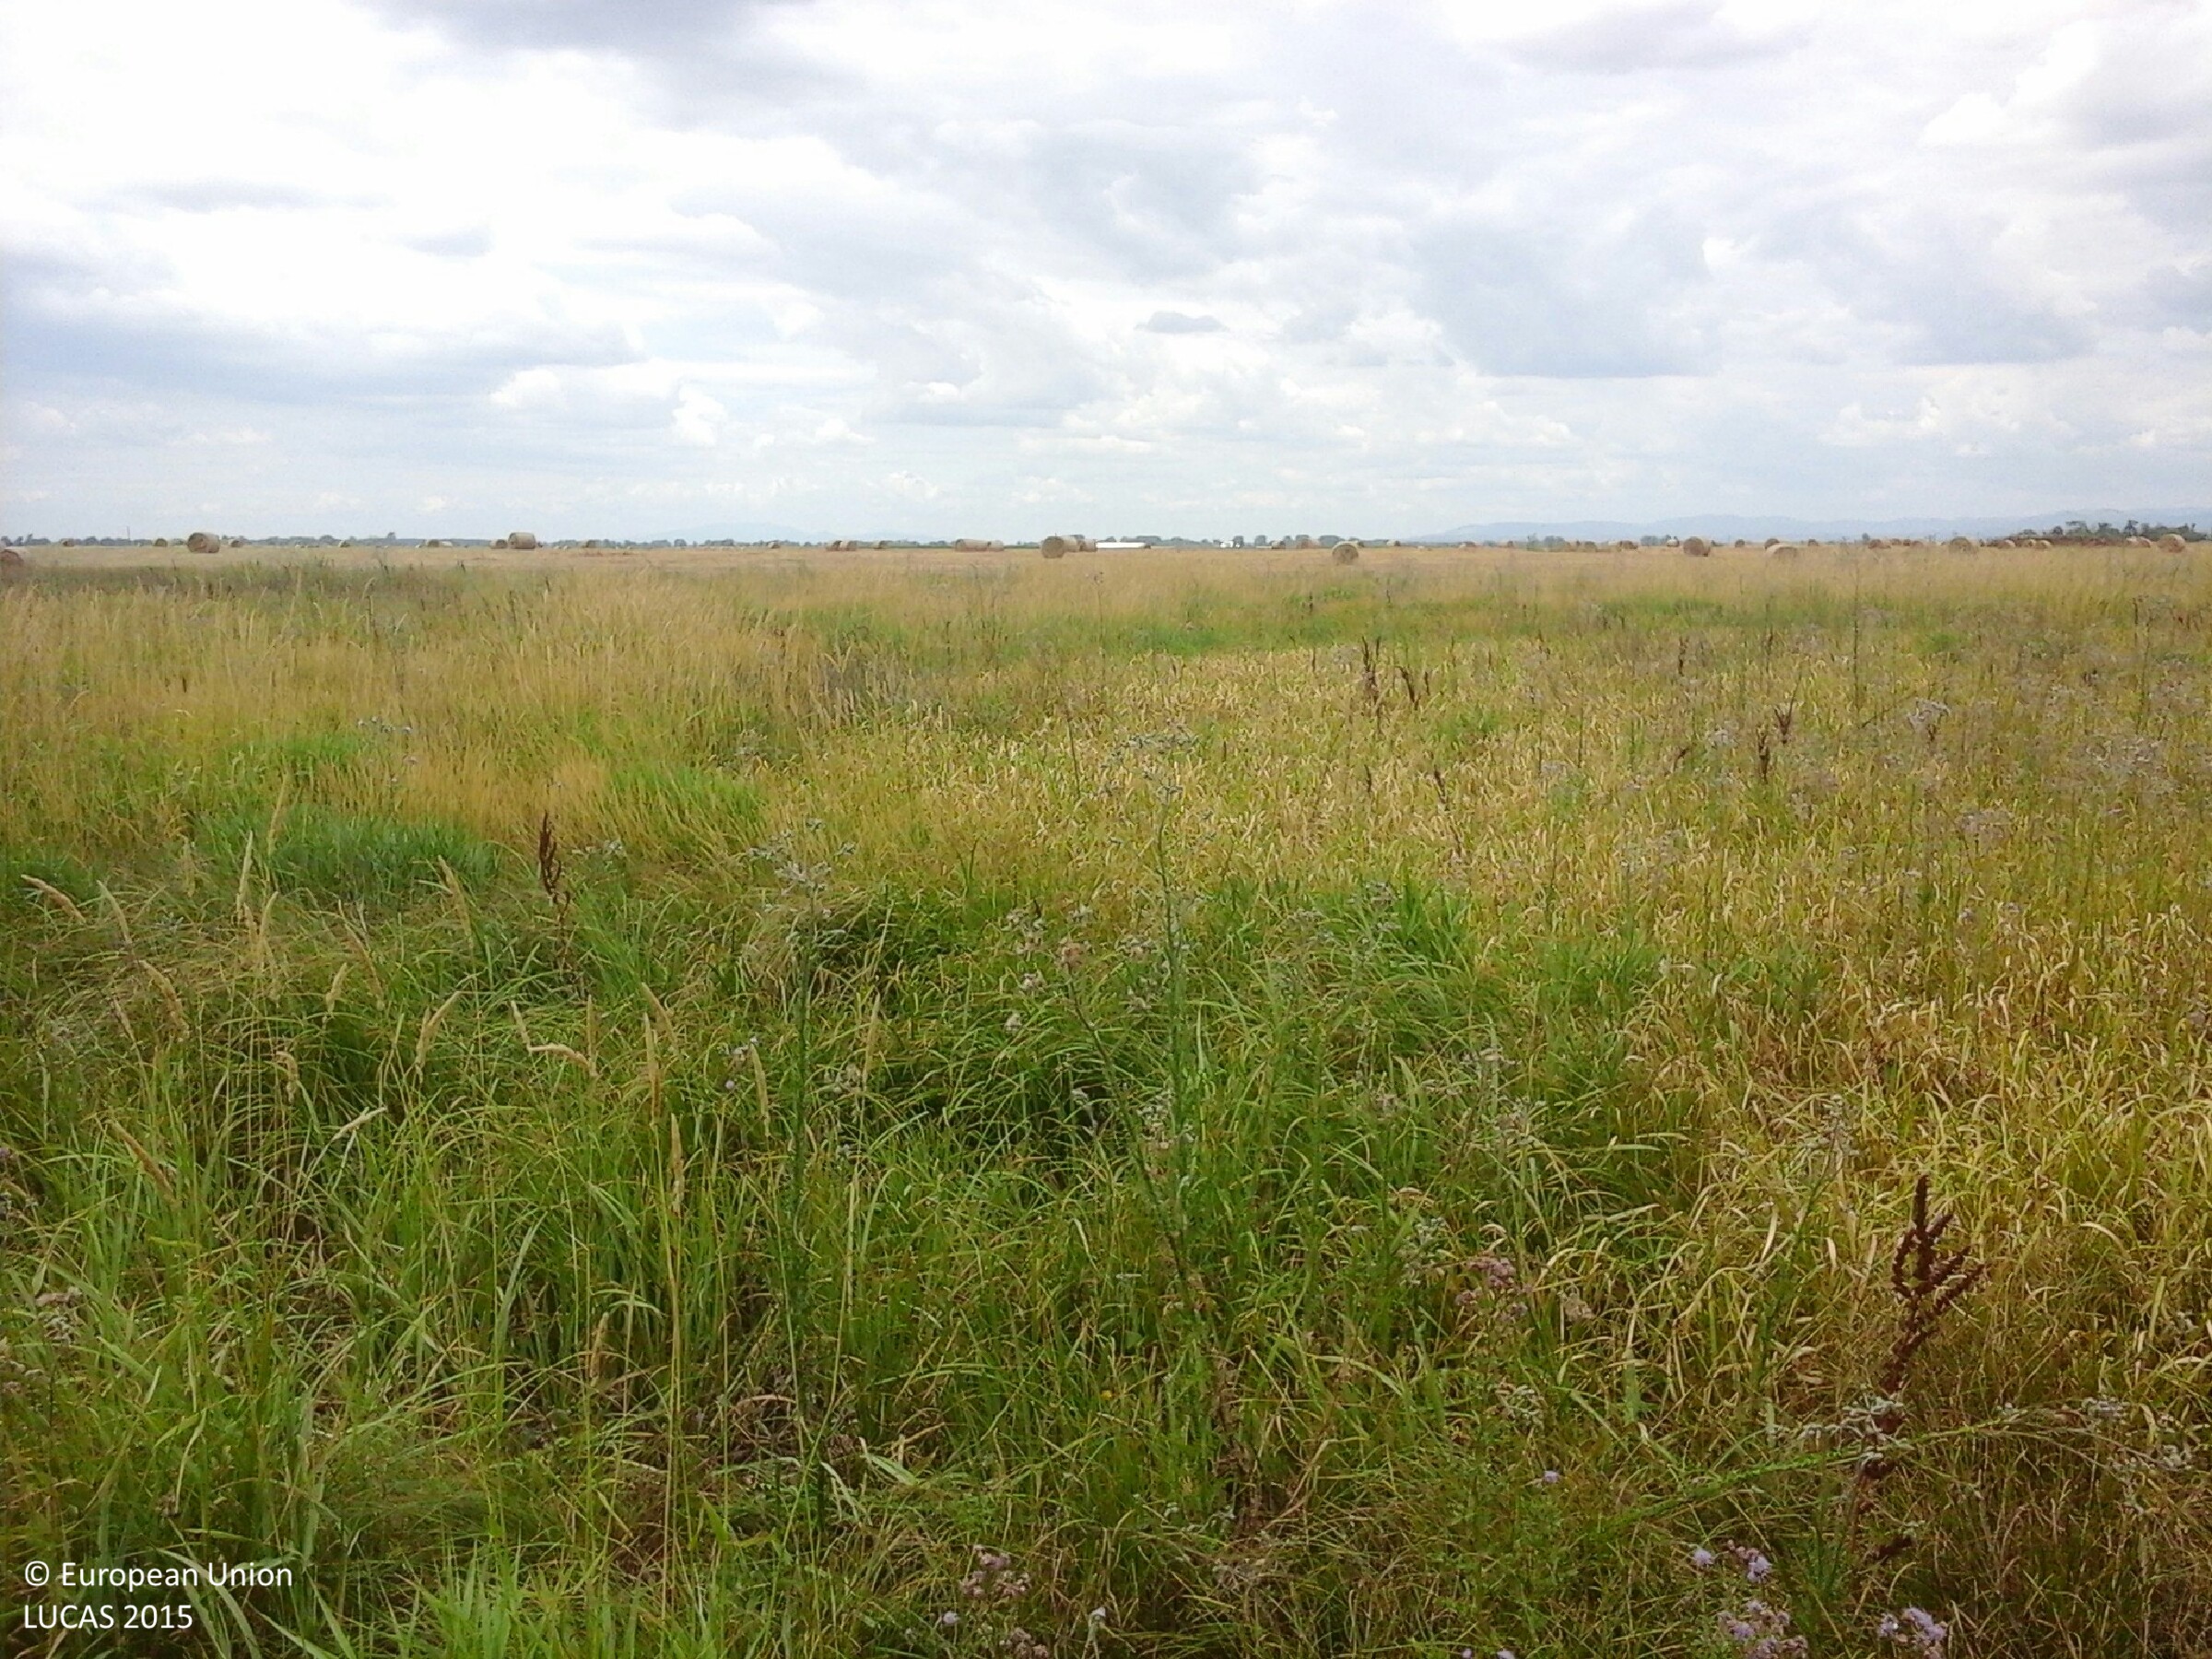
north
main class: Grassland
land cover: Grassland without tree/shrub cover
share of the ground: > 75 %
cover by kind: herbaceous plants 100 %
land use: Agriculture (excluding fallow land and kitchen gardens)
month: July
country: HU
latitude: 47.7788
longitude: 20.8327
